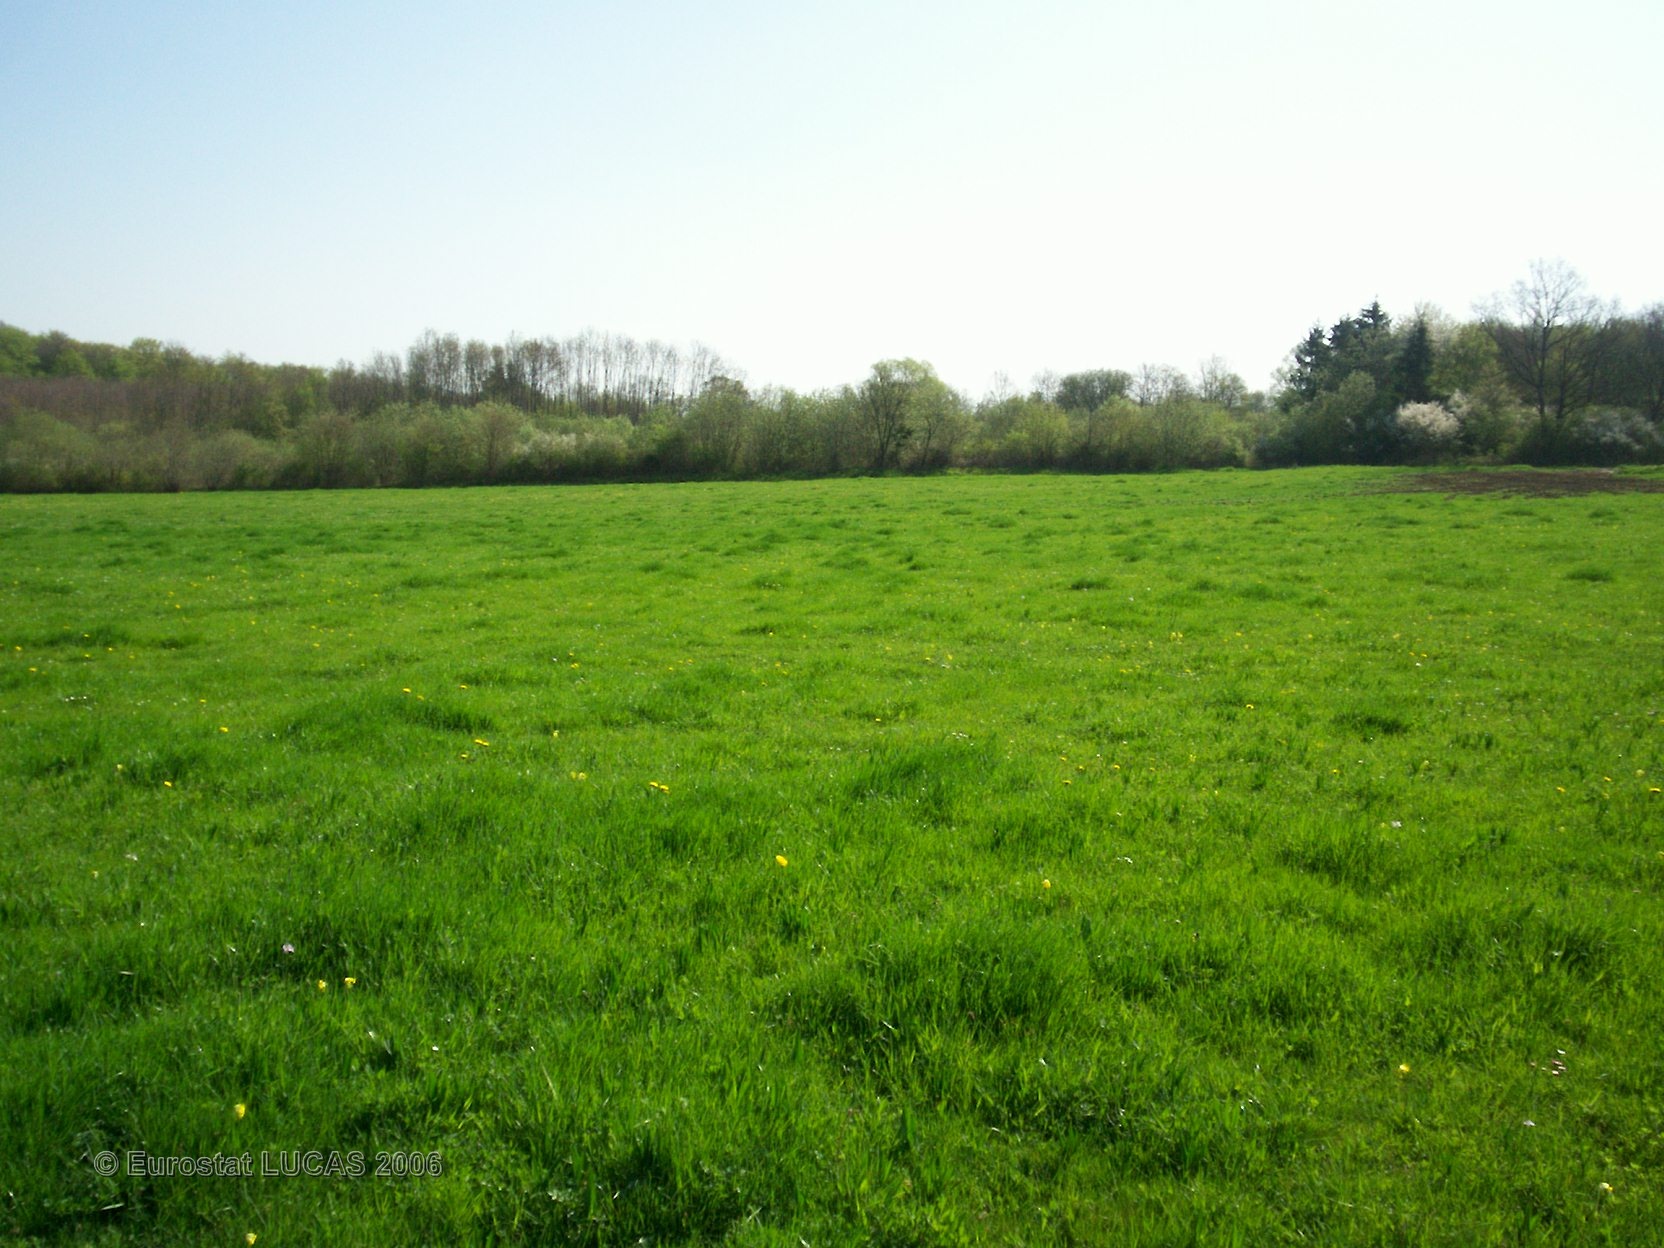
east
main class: Grassland
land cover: Grassland without tree/shrub cover
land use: Agriculture (excluding fallow land and kitchen gardens)
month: April
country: FR
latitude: 49.0582
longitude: 6.7570
